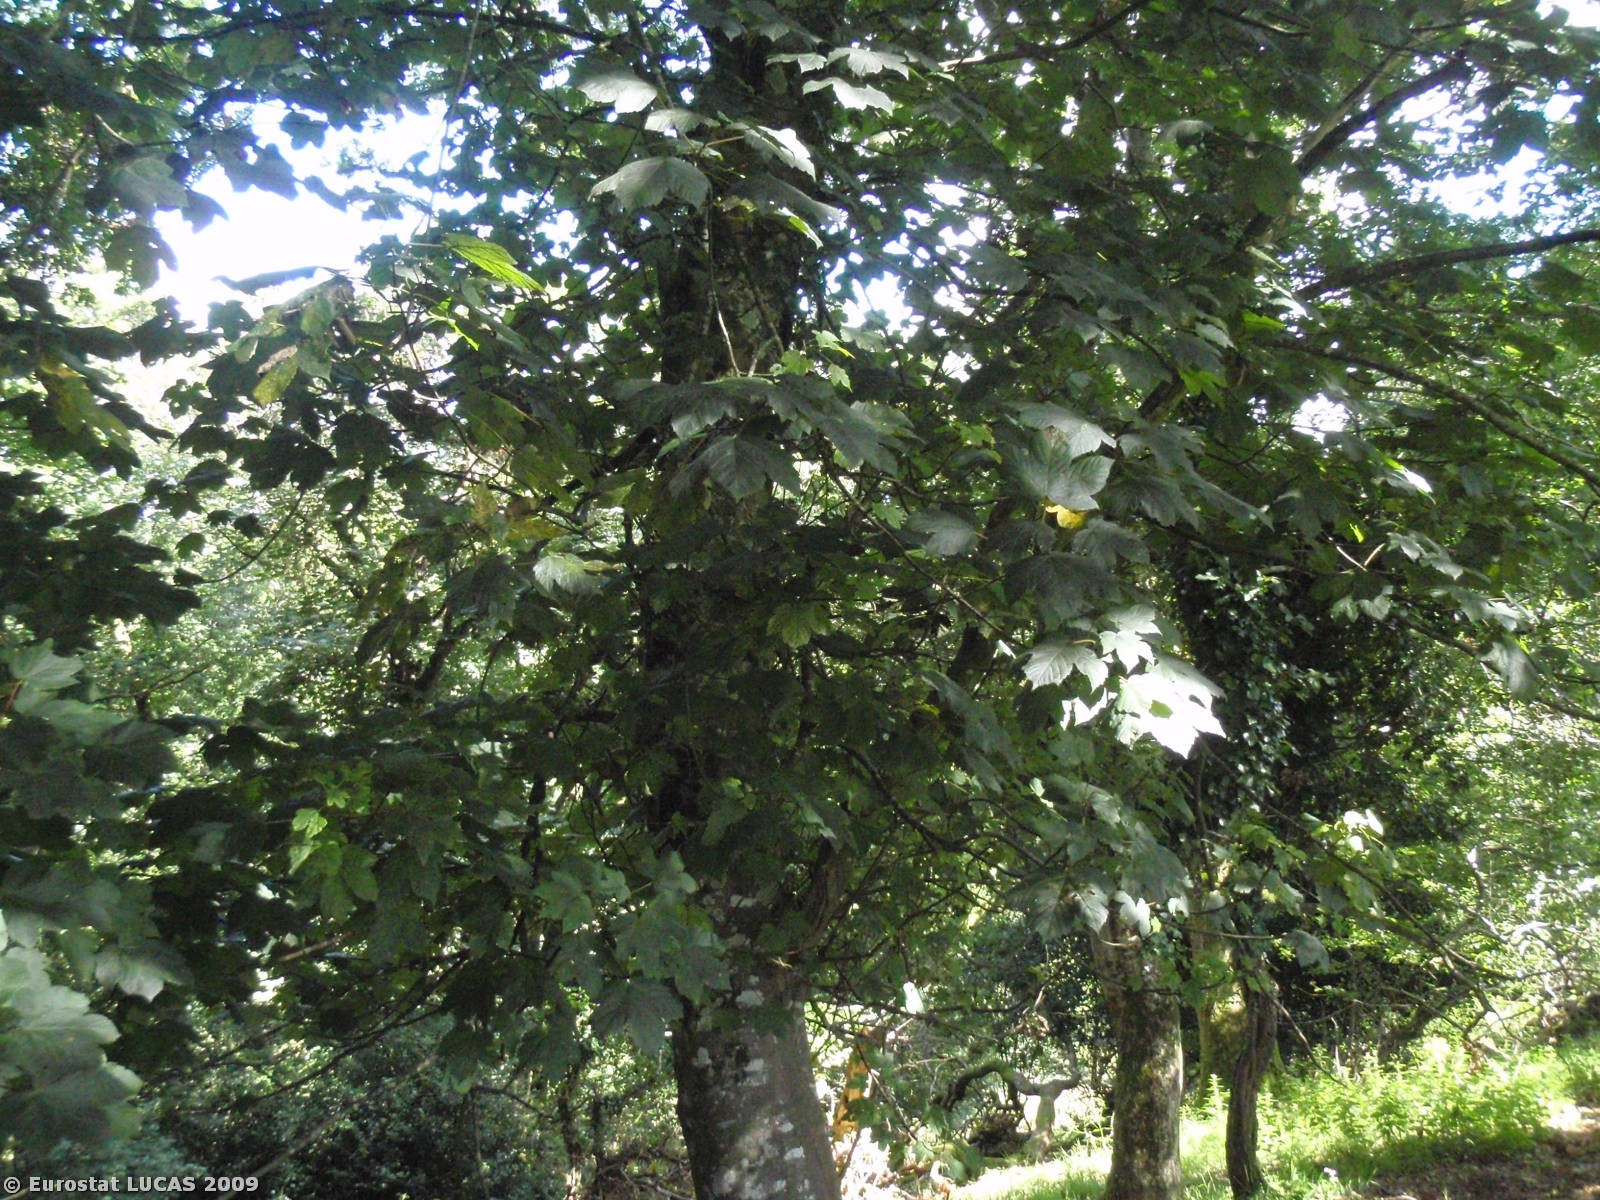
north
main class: Woodland
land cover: Broadleaved woodland
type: mesophytic deciduous forest
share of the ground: > 75 %
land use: Unused
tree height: > 5 m
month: August
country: GB
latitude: 50.6347
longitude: -4.3965
